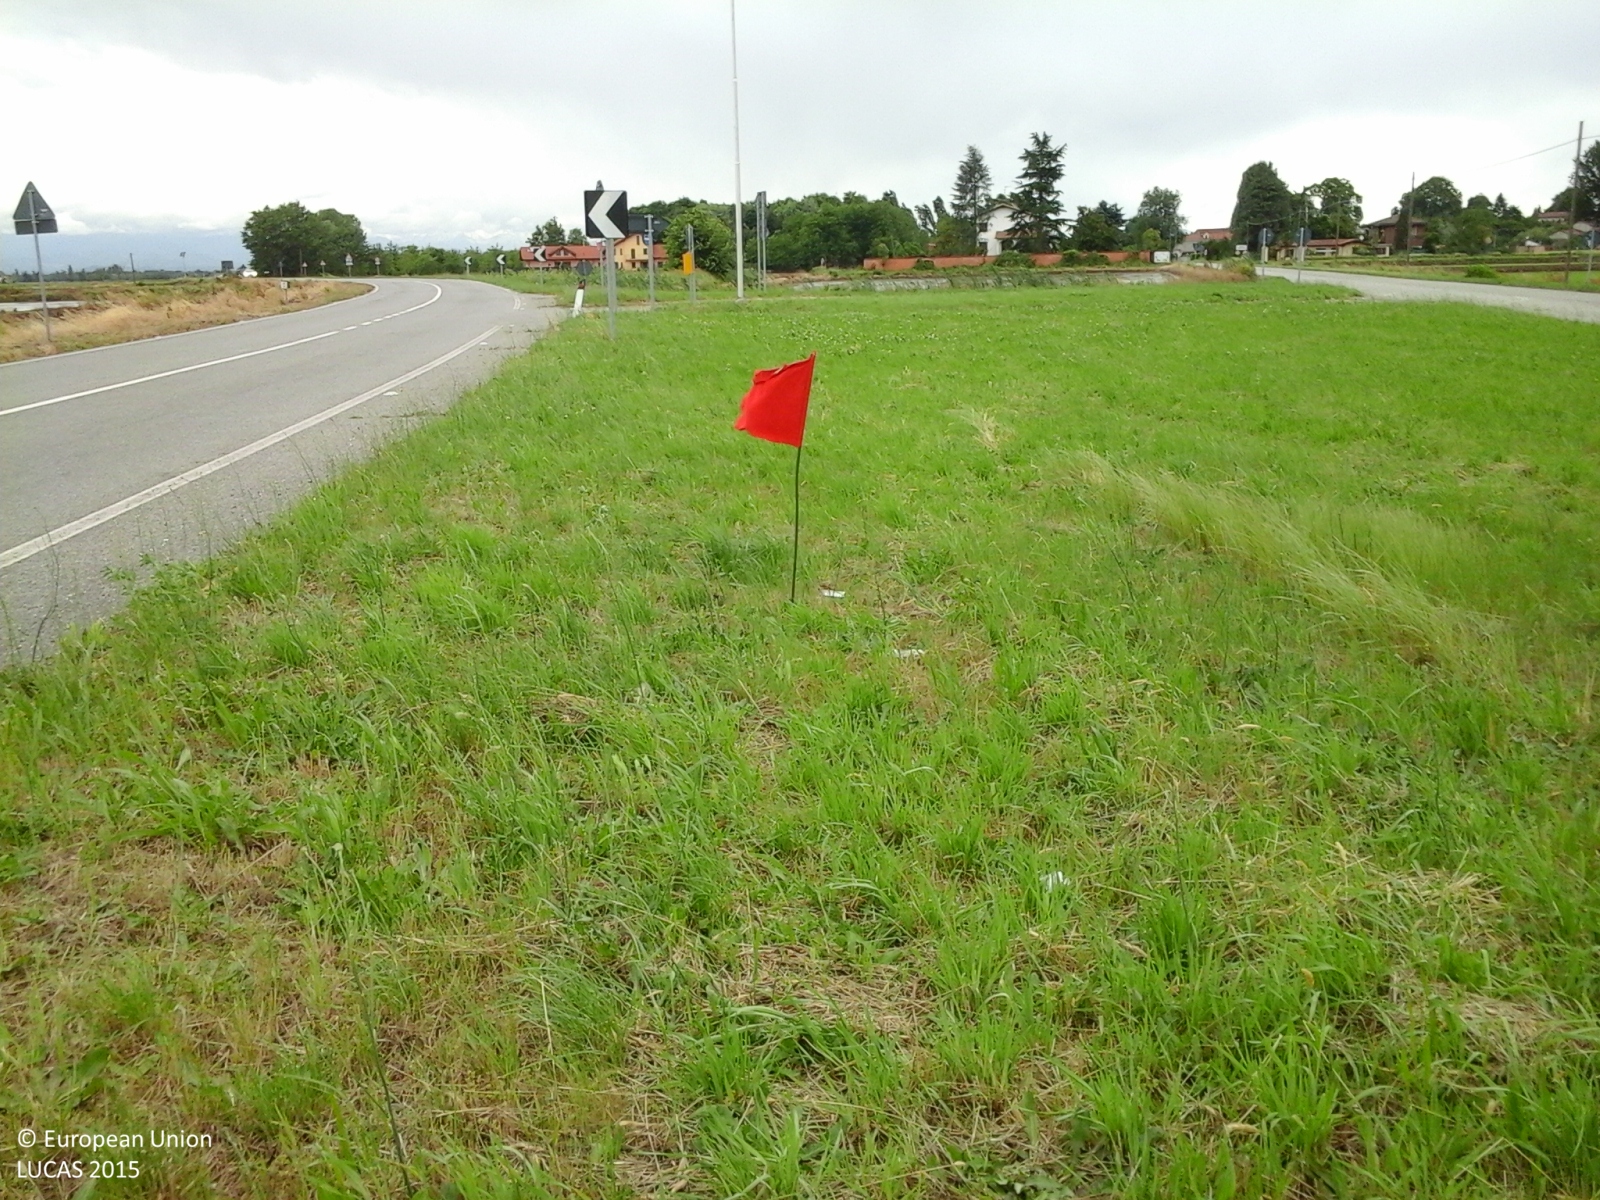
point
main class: Grassland
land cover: Grassland without tree/shrub cover
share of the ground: > 75 %
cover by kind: herbaceous plants 85 %, consolidated bare surface 15 %
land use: Road transport
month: May
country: IT
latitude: 45.4199
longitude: 8.3797
